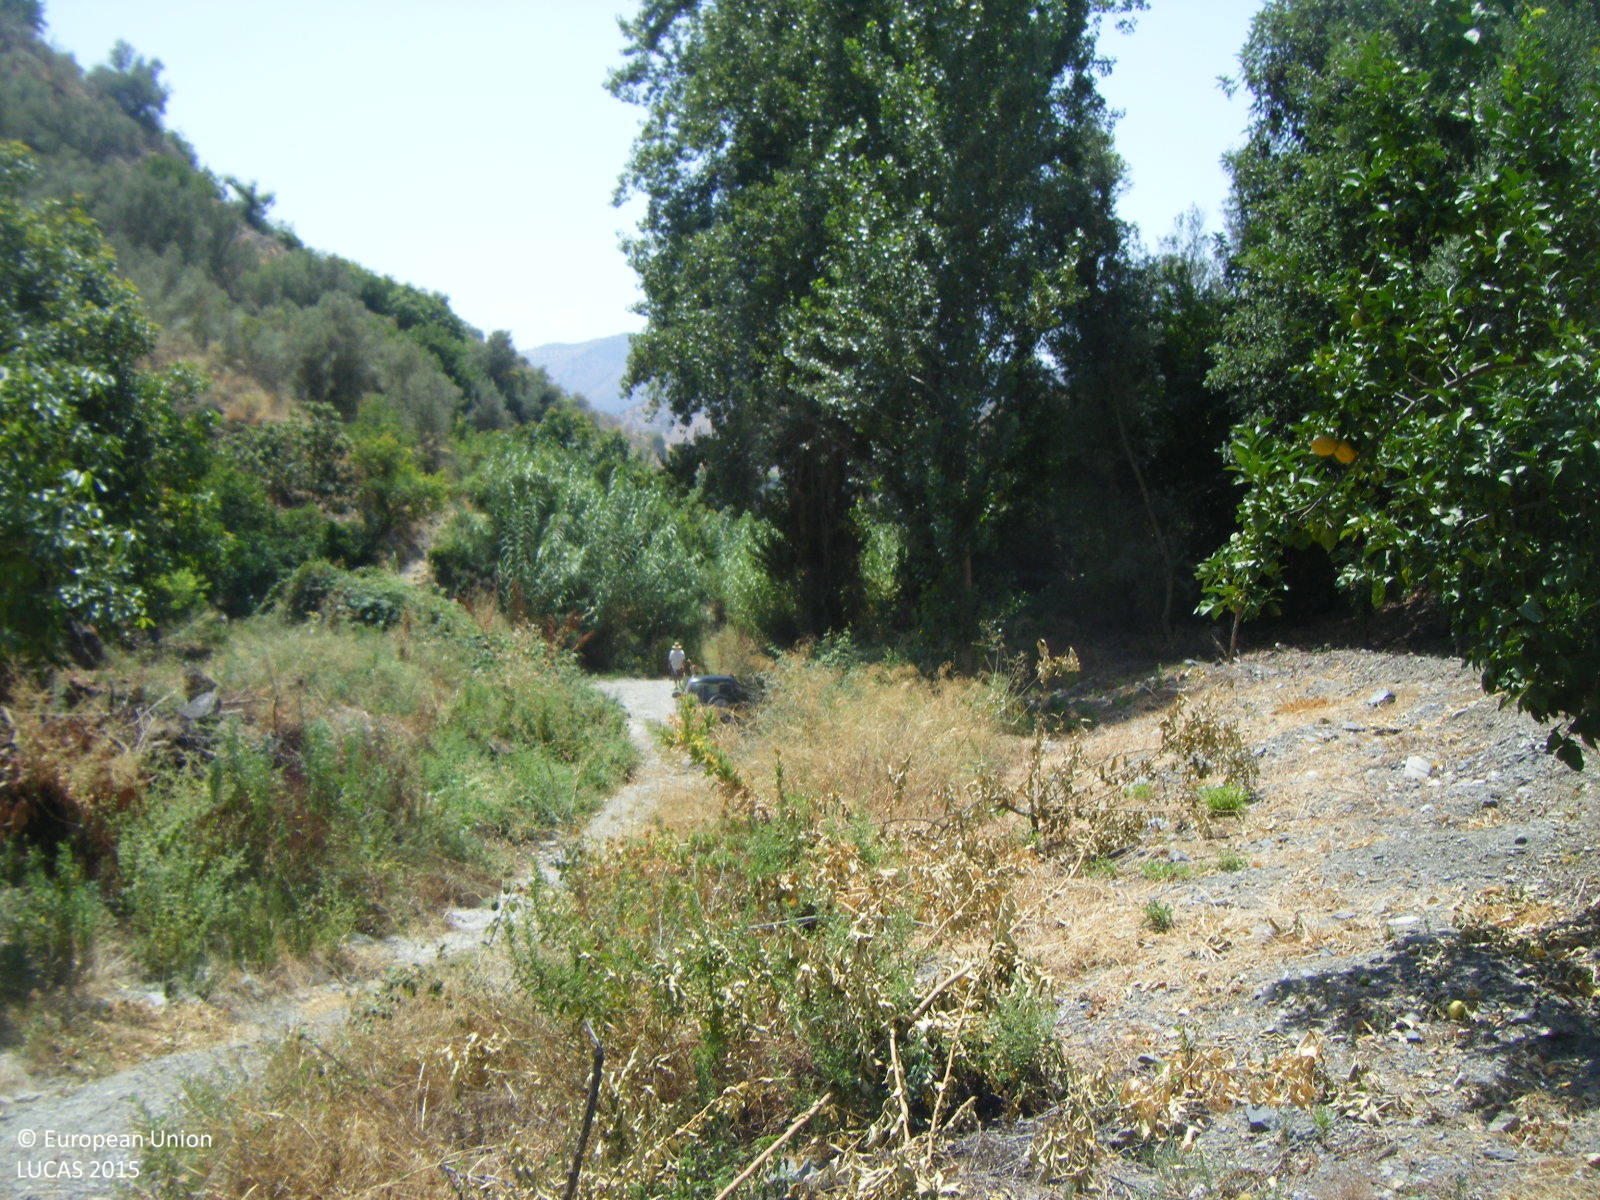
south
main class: Cropland
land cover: Oranges
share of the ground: 10 - 25 %
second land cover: Other bare soil
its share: > 75 %
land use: Agriculture (excluding fallow land and kitchen gardens)
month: July
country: ES
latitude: 36.8552
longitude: -4.1096
